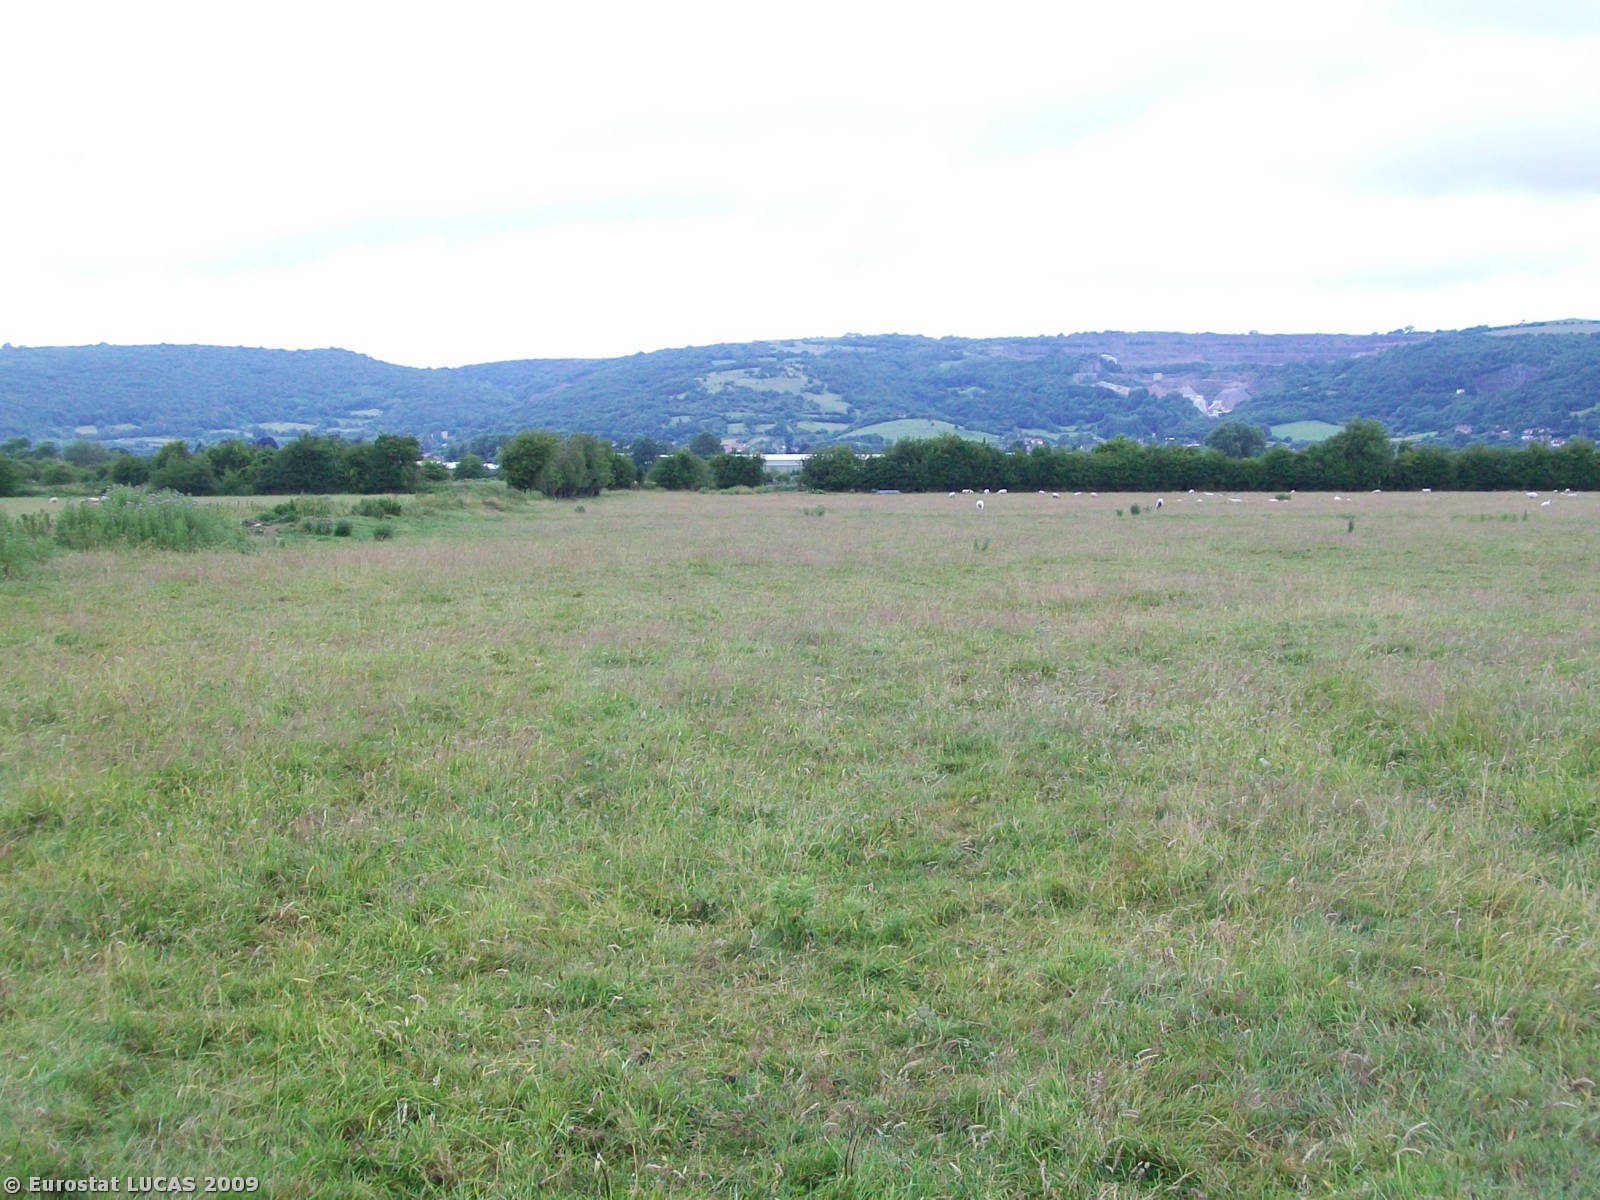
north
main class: Grassland
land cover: Grassland without tree/shrub cover
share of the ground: > 75 %
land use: Agriculture (excluding fallow land and kitchen gardens)
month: July
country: GB
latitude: 51.2639
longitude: -2.7831
